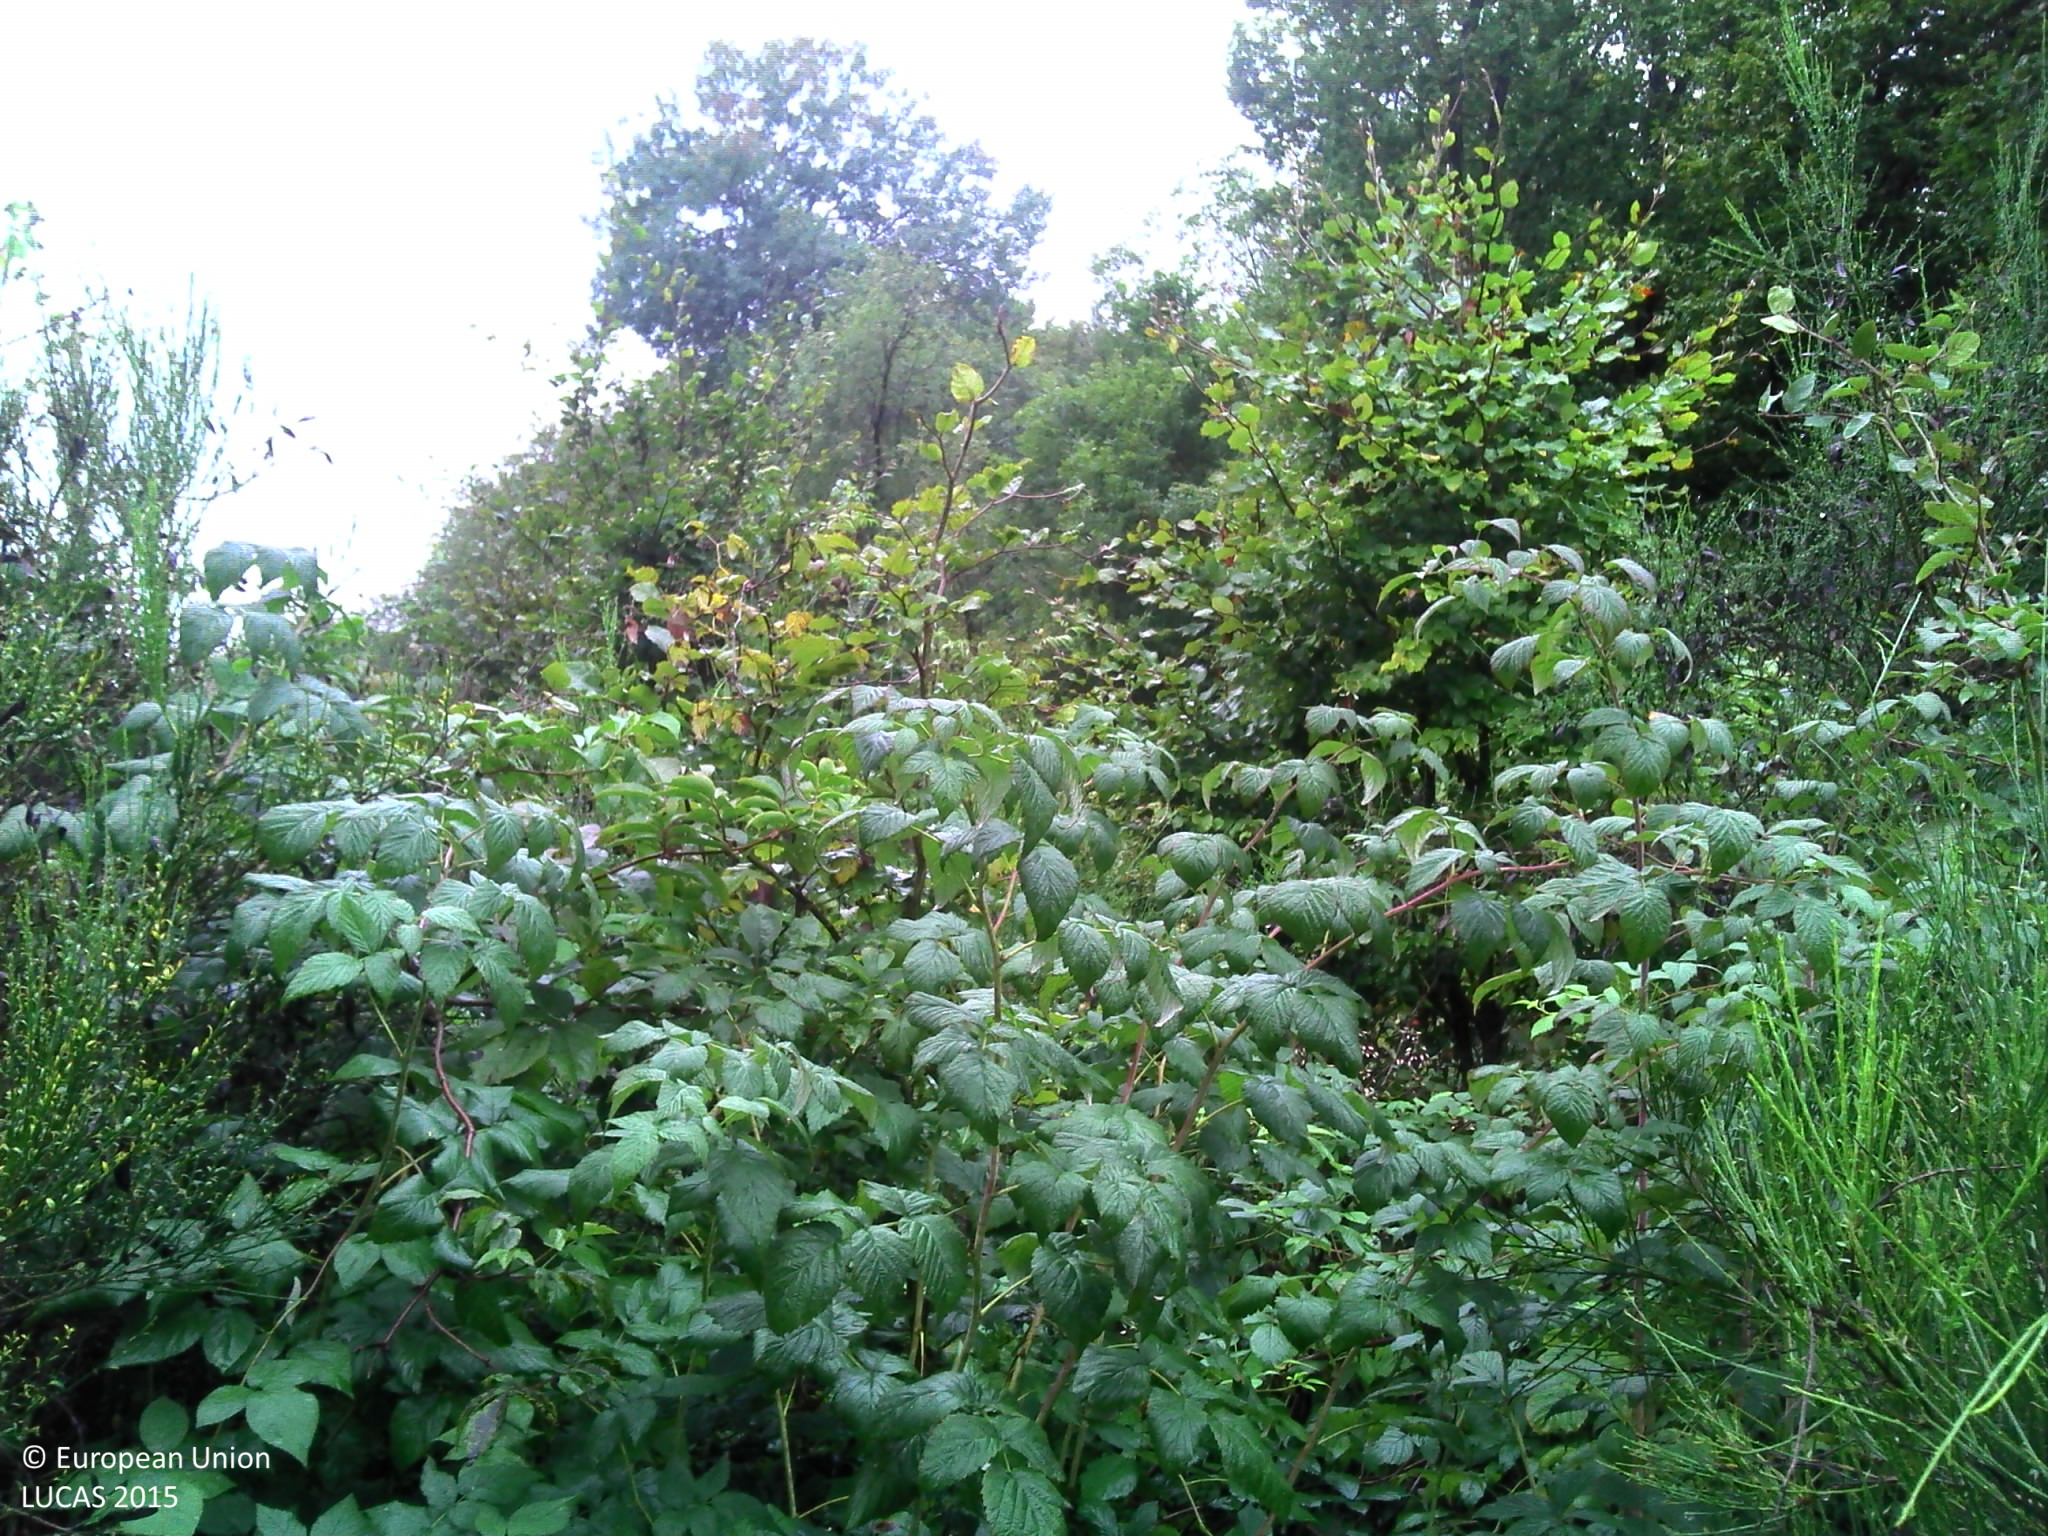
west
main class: Shrubland
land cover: Shrubland with sparse tree cover
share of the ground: > 75 %
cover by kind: shrubs 95 %, broadleaved forest trees 5 %
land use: Forestry
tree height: < 5 m
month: September
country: LU
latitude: 49.8045
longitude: 5.9001
